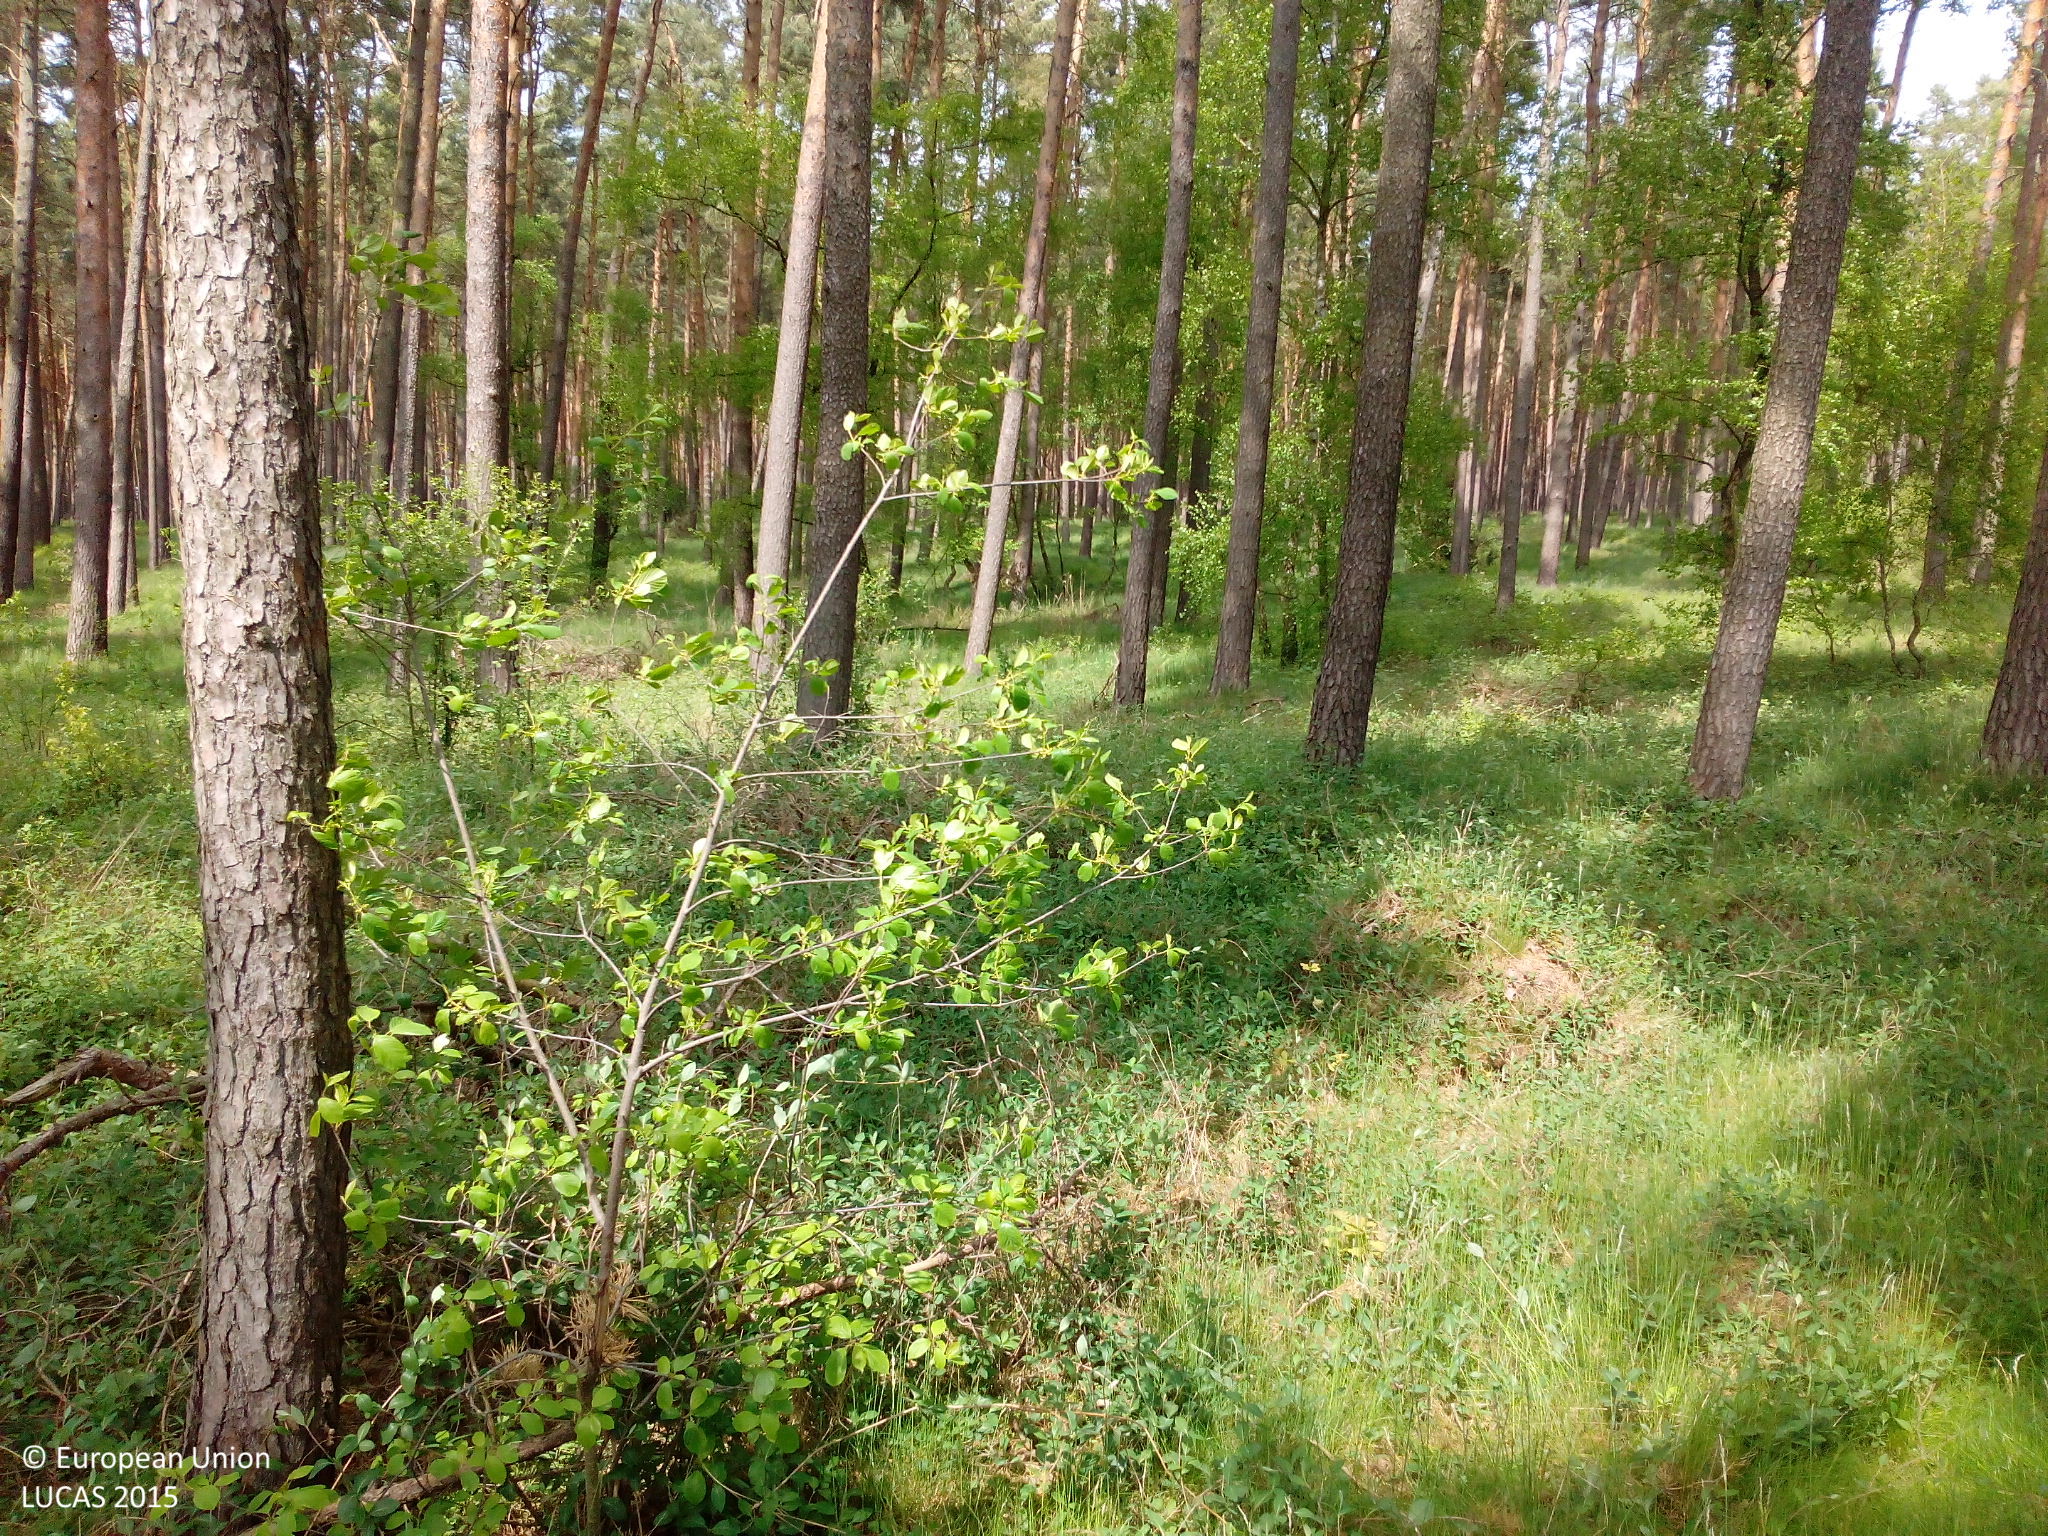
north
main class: Woodland
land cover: Pine dominated coniferous woodland
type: hemiboreal forest and nemoral coniferous forest and mixed broadleaved-coniferous forest
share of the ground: 50 - 75 %
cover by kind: coniferous forest trees 60 %, herbaceous plants 30 %, shrubs 10 %
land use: Forestry
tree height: > 5 m
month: May
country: DE
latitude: 52.6596
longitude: 11.1380
